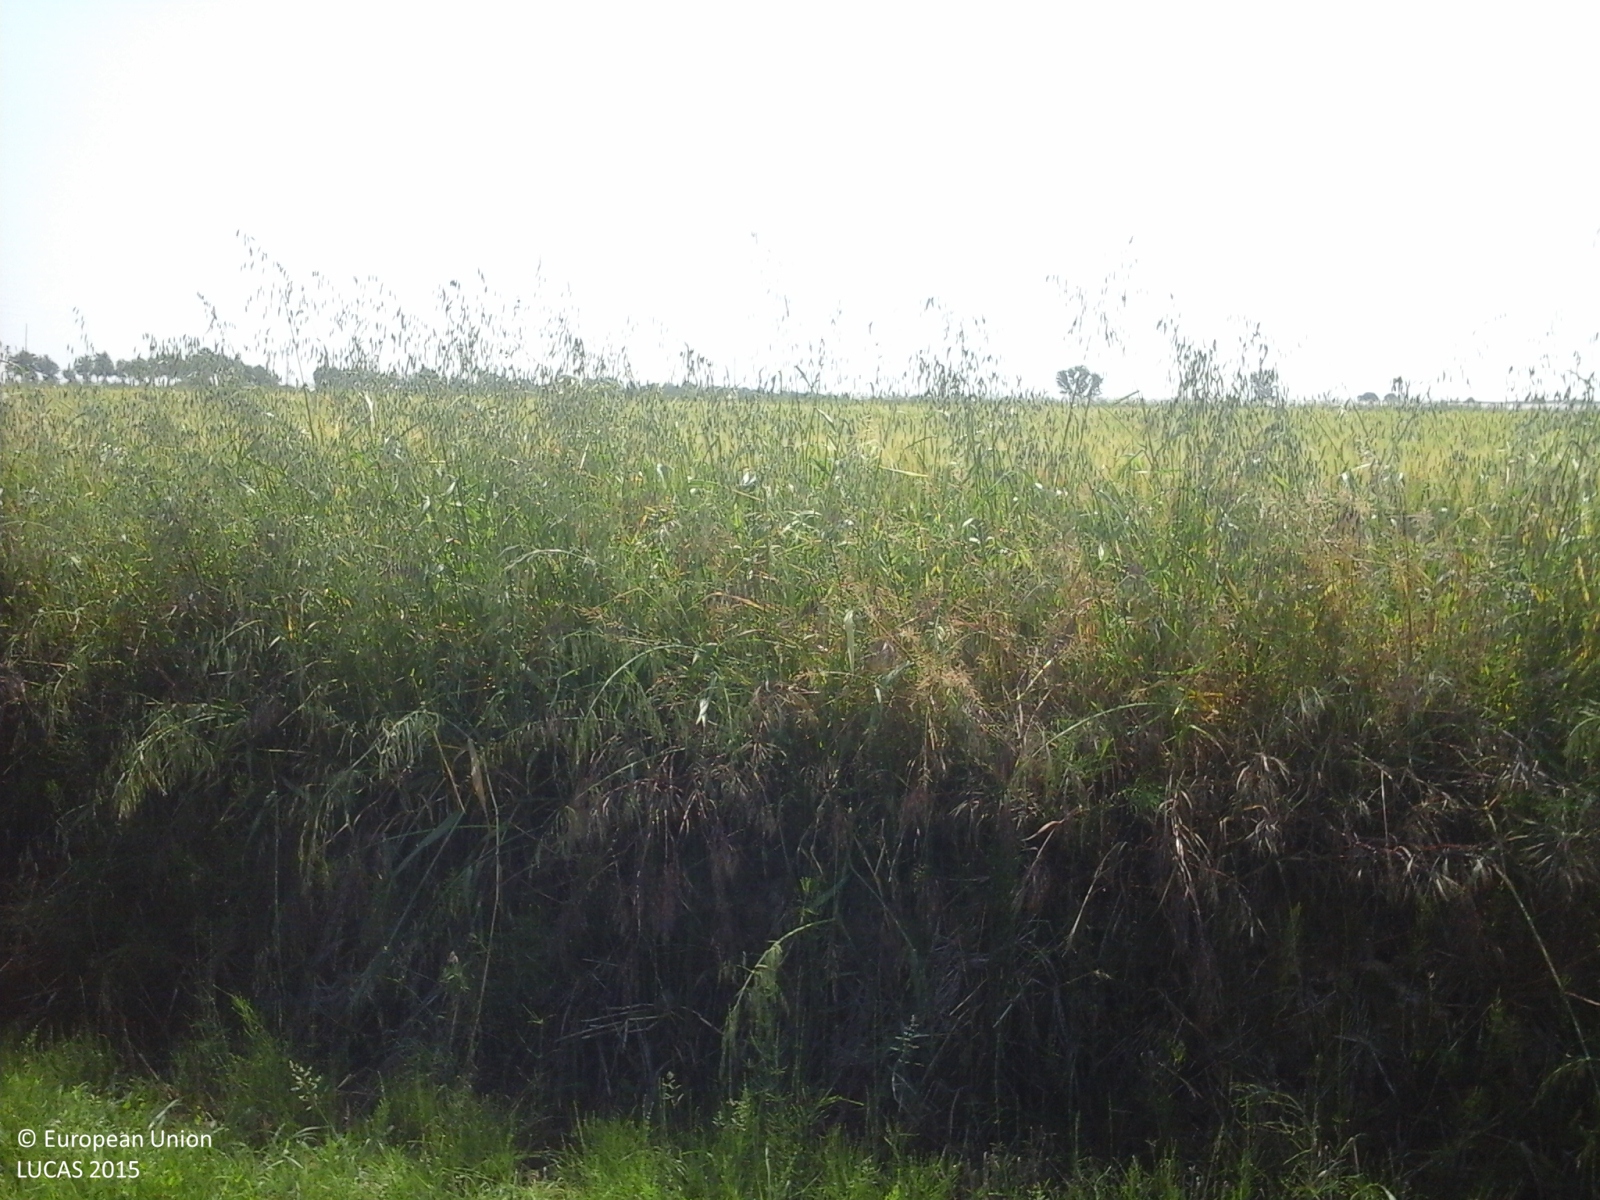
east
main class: Artificial land
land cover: Non built-up linear features
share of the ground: > 75 %
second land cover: Grassland without tree/shrub cover
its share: > 75 %
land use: Road transport
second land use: Agriculture (excluding fallow land and kitchen gardens)
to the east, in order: Artificial constructions in urban areas; Grassland without tree/shrub cover; Ditches and canals; Common wheat; Ditches and canals; Maize; Ditches and canals; Tracks; Apple fruit
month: May
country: IT
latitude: 44.8060
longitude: 11.6782
